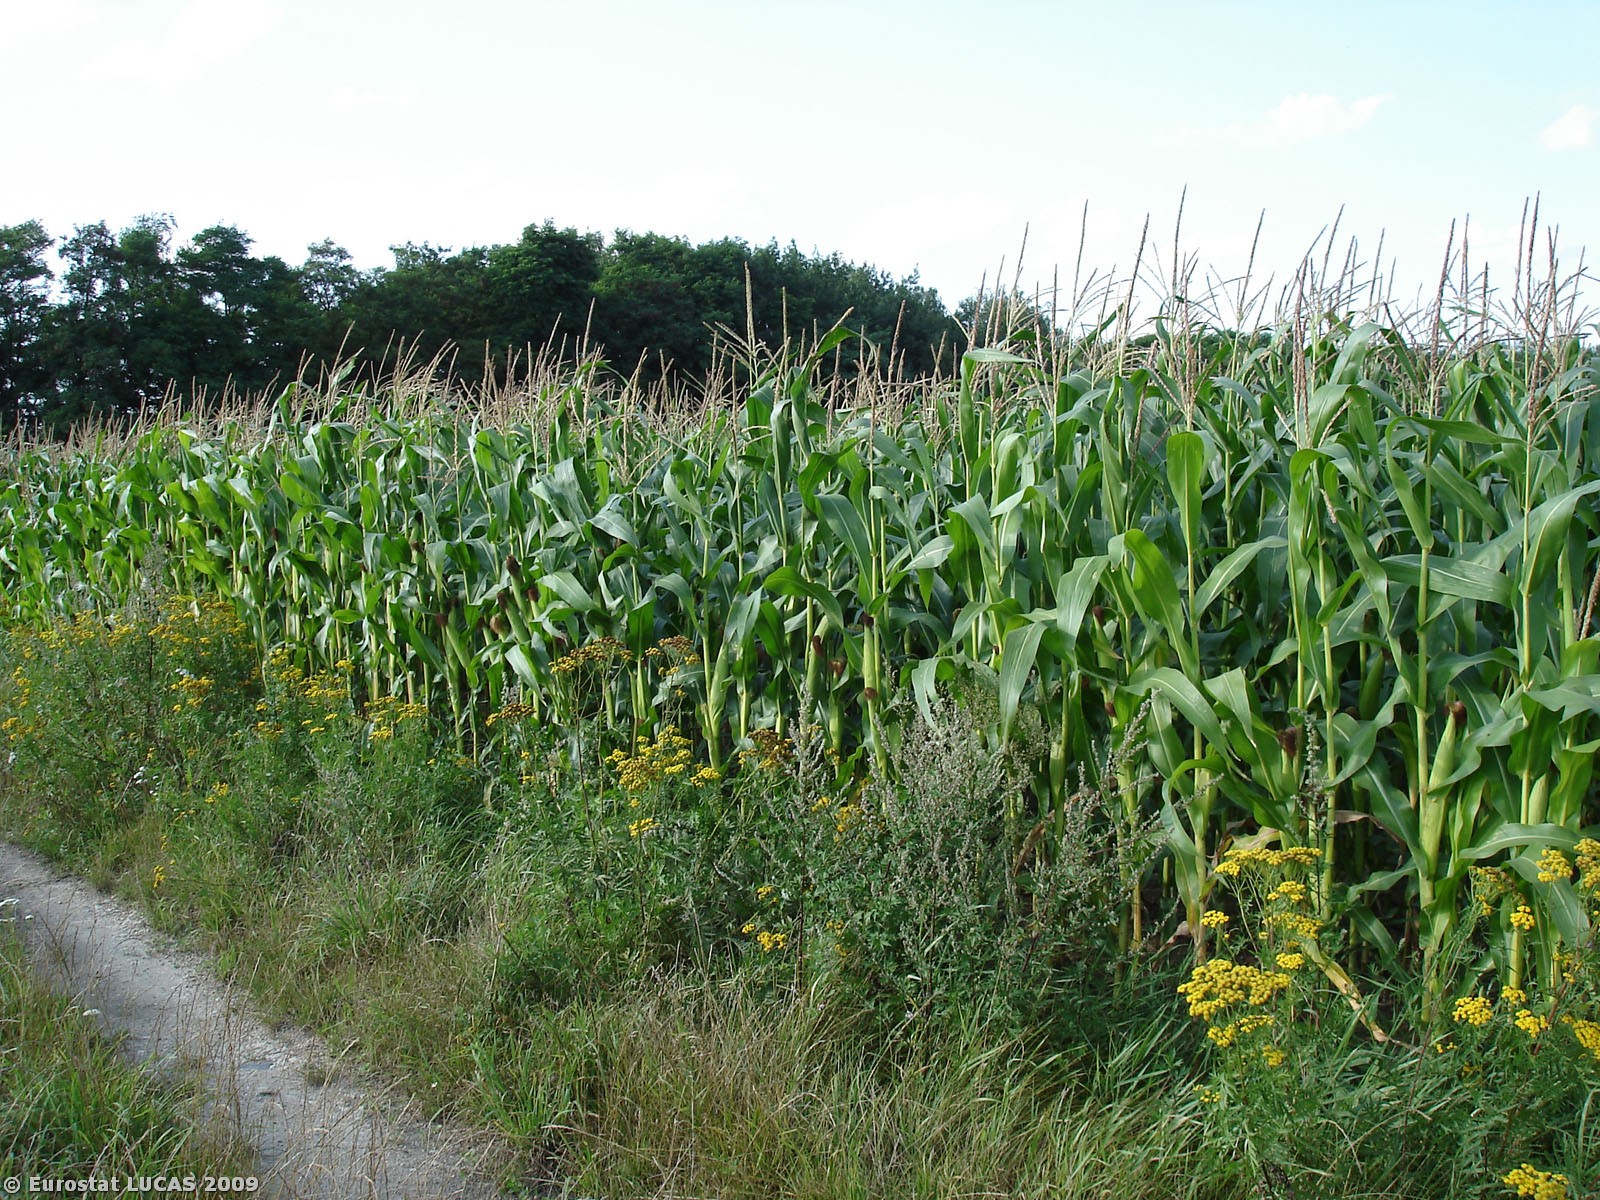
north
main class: Cropland
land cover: Maize
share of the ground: > 75 %
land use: Agriculture (excluding fallow land and kitchen gardens)
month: August
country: PL
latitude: 50.9844
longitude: 18.2942
